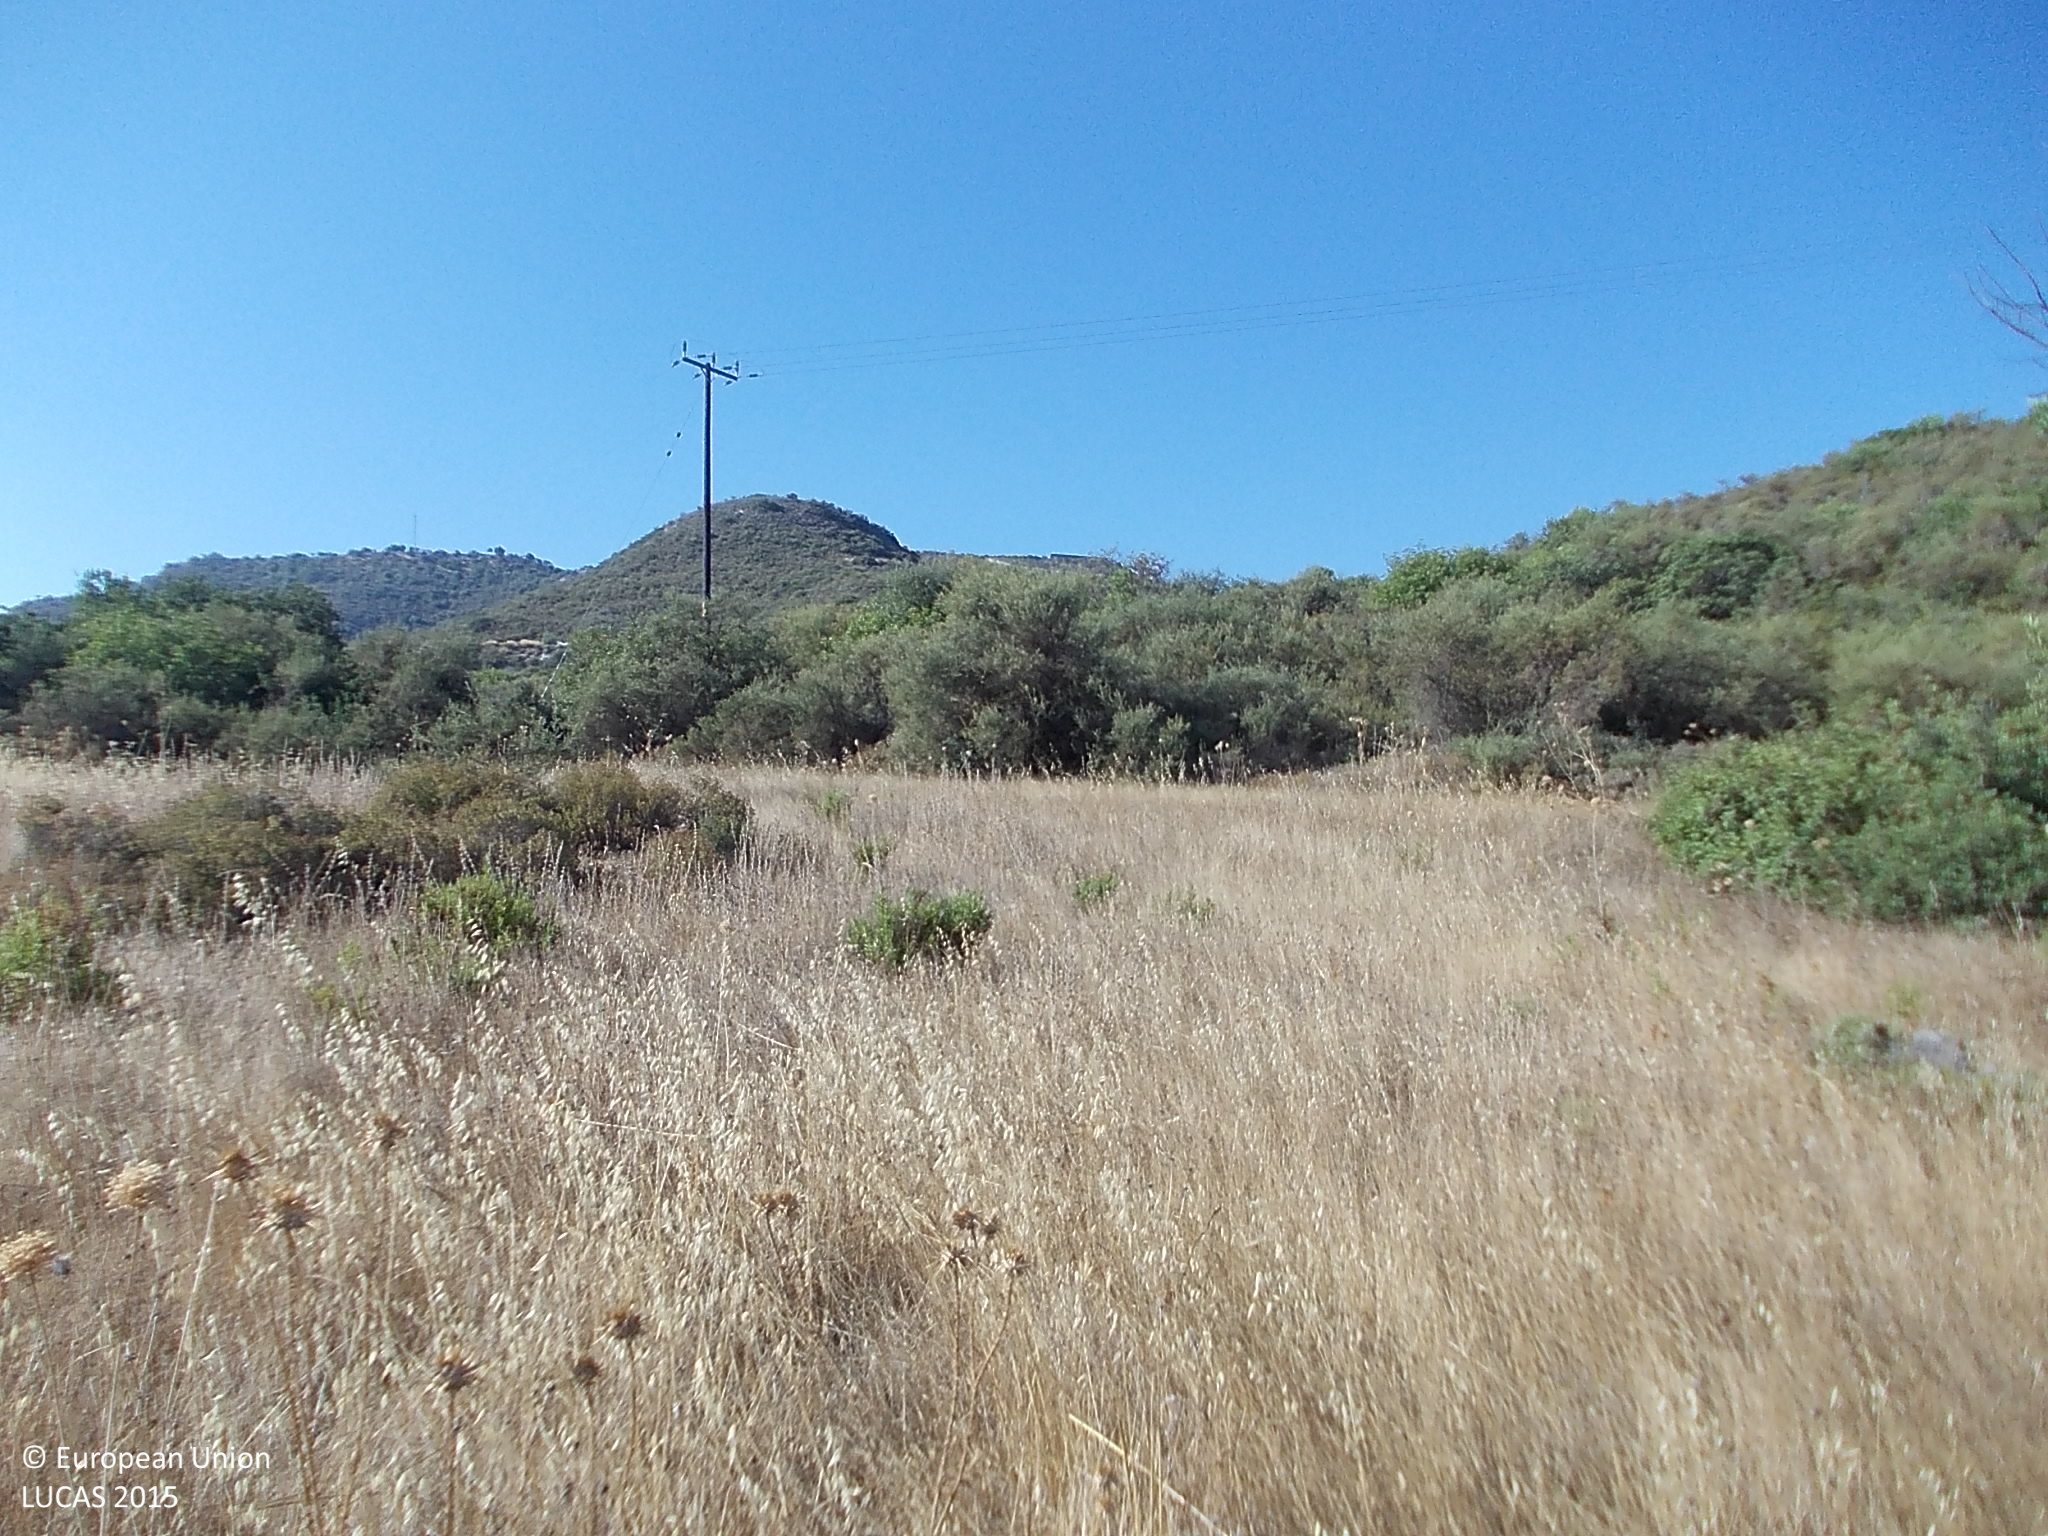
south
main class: Grassland
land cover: Grassland with sparse tree/shrub cover
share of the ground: > 75 %
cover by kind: herbaceous plants 90 %, coniferous forest trees 5 %, shrubs 5 %
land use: Semi-natural and natural areas not in use
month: August
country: CY
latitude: 34.7638
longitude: 32.8979
